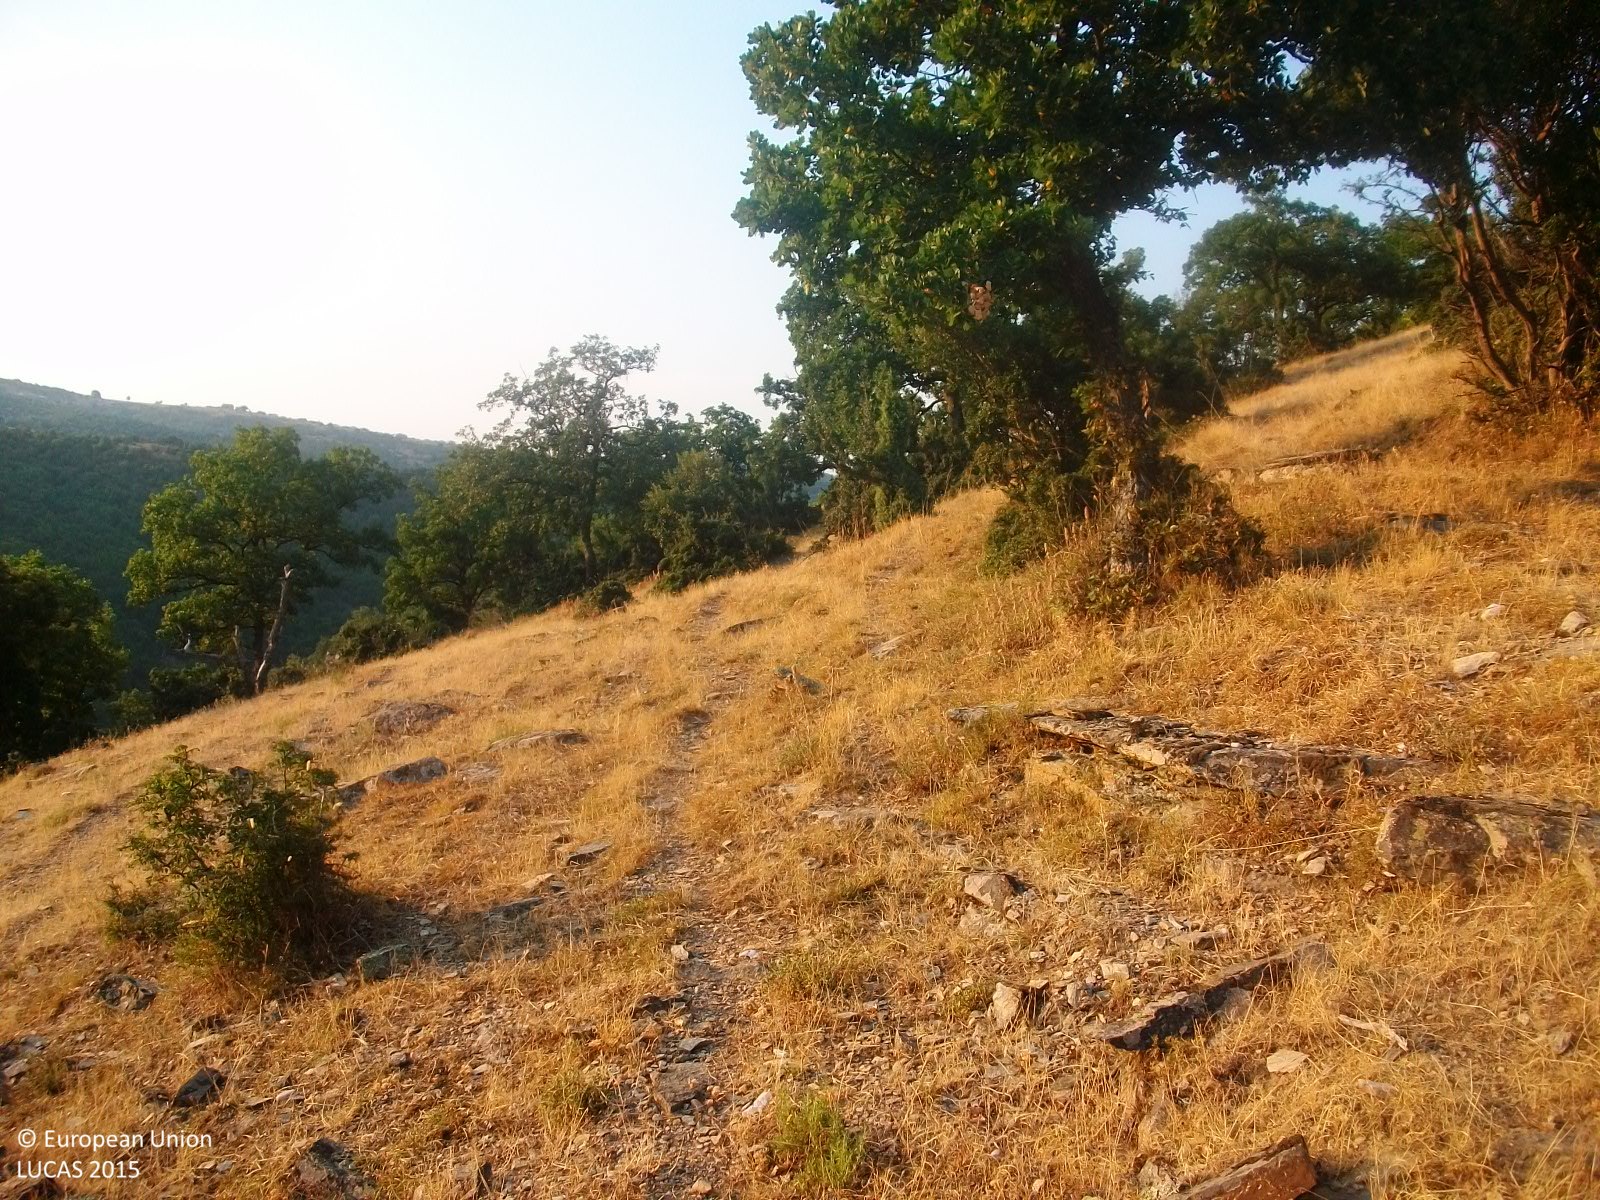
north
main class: Grassland
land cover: Grassland with sparse tree/shrub cover
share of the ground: > 75 %
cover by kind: herbaceous plants 85 %, shrubs 10 %, broadleaved forest trees 5 %
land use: Agriculture (excluding fallow land and kitchen gardens)
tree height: > 5 m
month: July
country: GR
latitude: 41.2762
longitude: 26.0269
